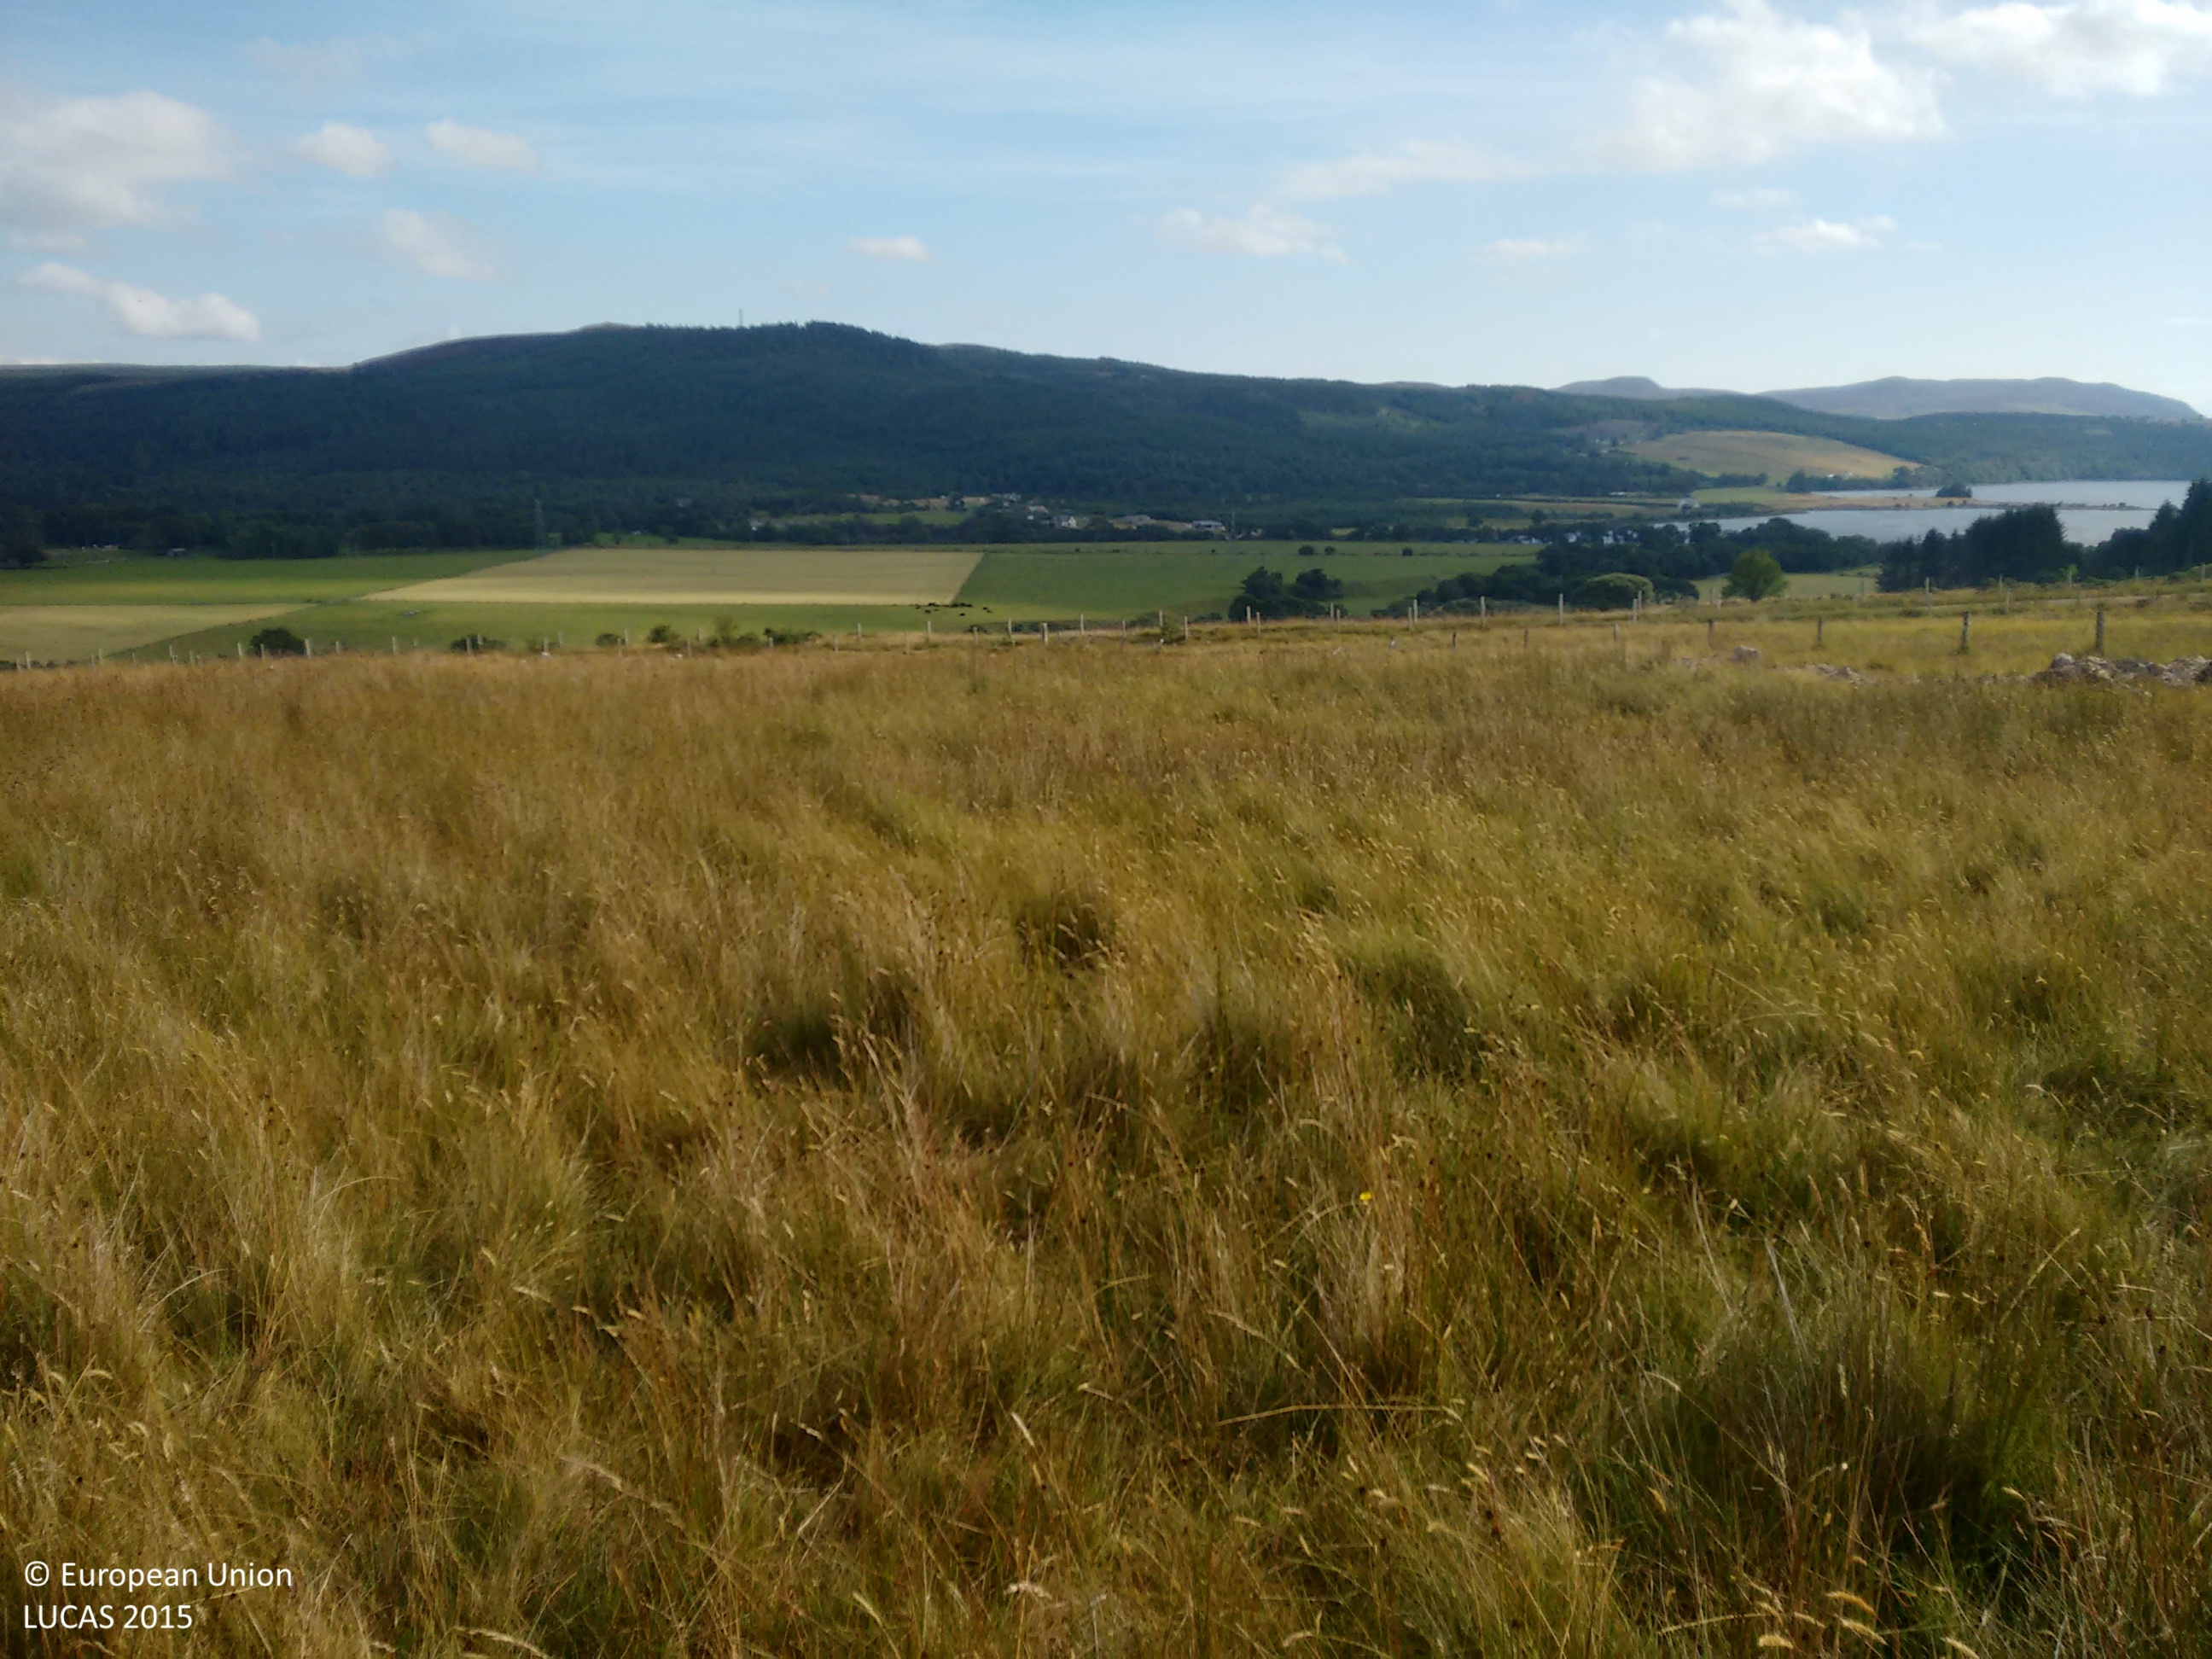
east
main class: Grassland
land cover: Grassland without tree/shrub cover
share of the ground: > 75 %
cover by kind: herbaceous plants 100 %
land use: Agriculture (excluding fallow land and kitchen gardens)
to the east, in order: Grassland without tree/shrub cover; Artificial constructions; Grassland without tree/shrub cover; Fences; Grassland without tree/shrub cover; Fences; Grass margins; Paved roads, cycling and walking lanes; Fences; Grassland without tree/shrub cover; Artificial constructions; Ditches and canals; Managed hedges; Grassland without tree/shrub cover; Artificial constructions; Grassland without tree/shrub cover
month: September
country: GB
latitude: 57.9127
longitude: -4.4164
